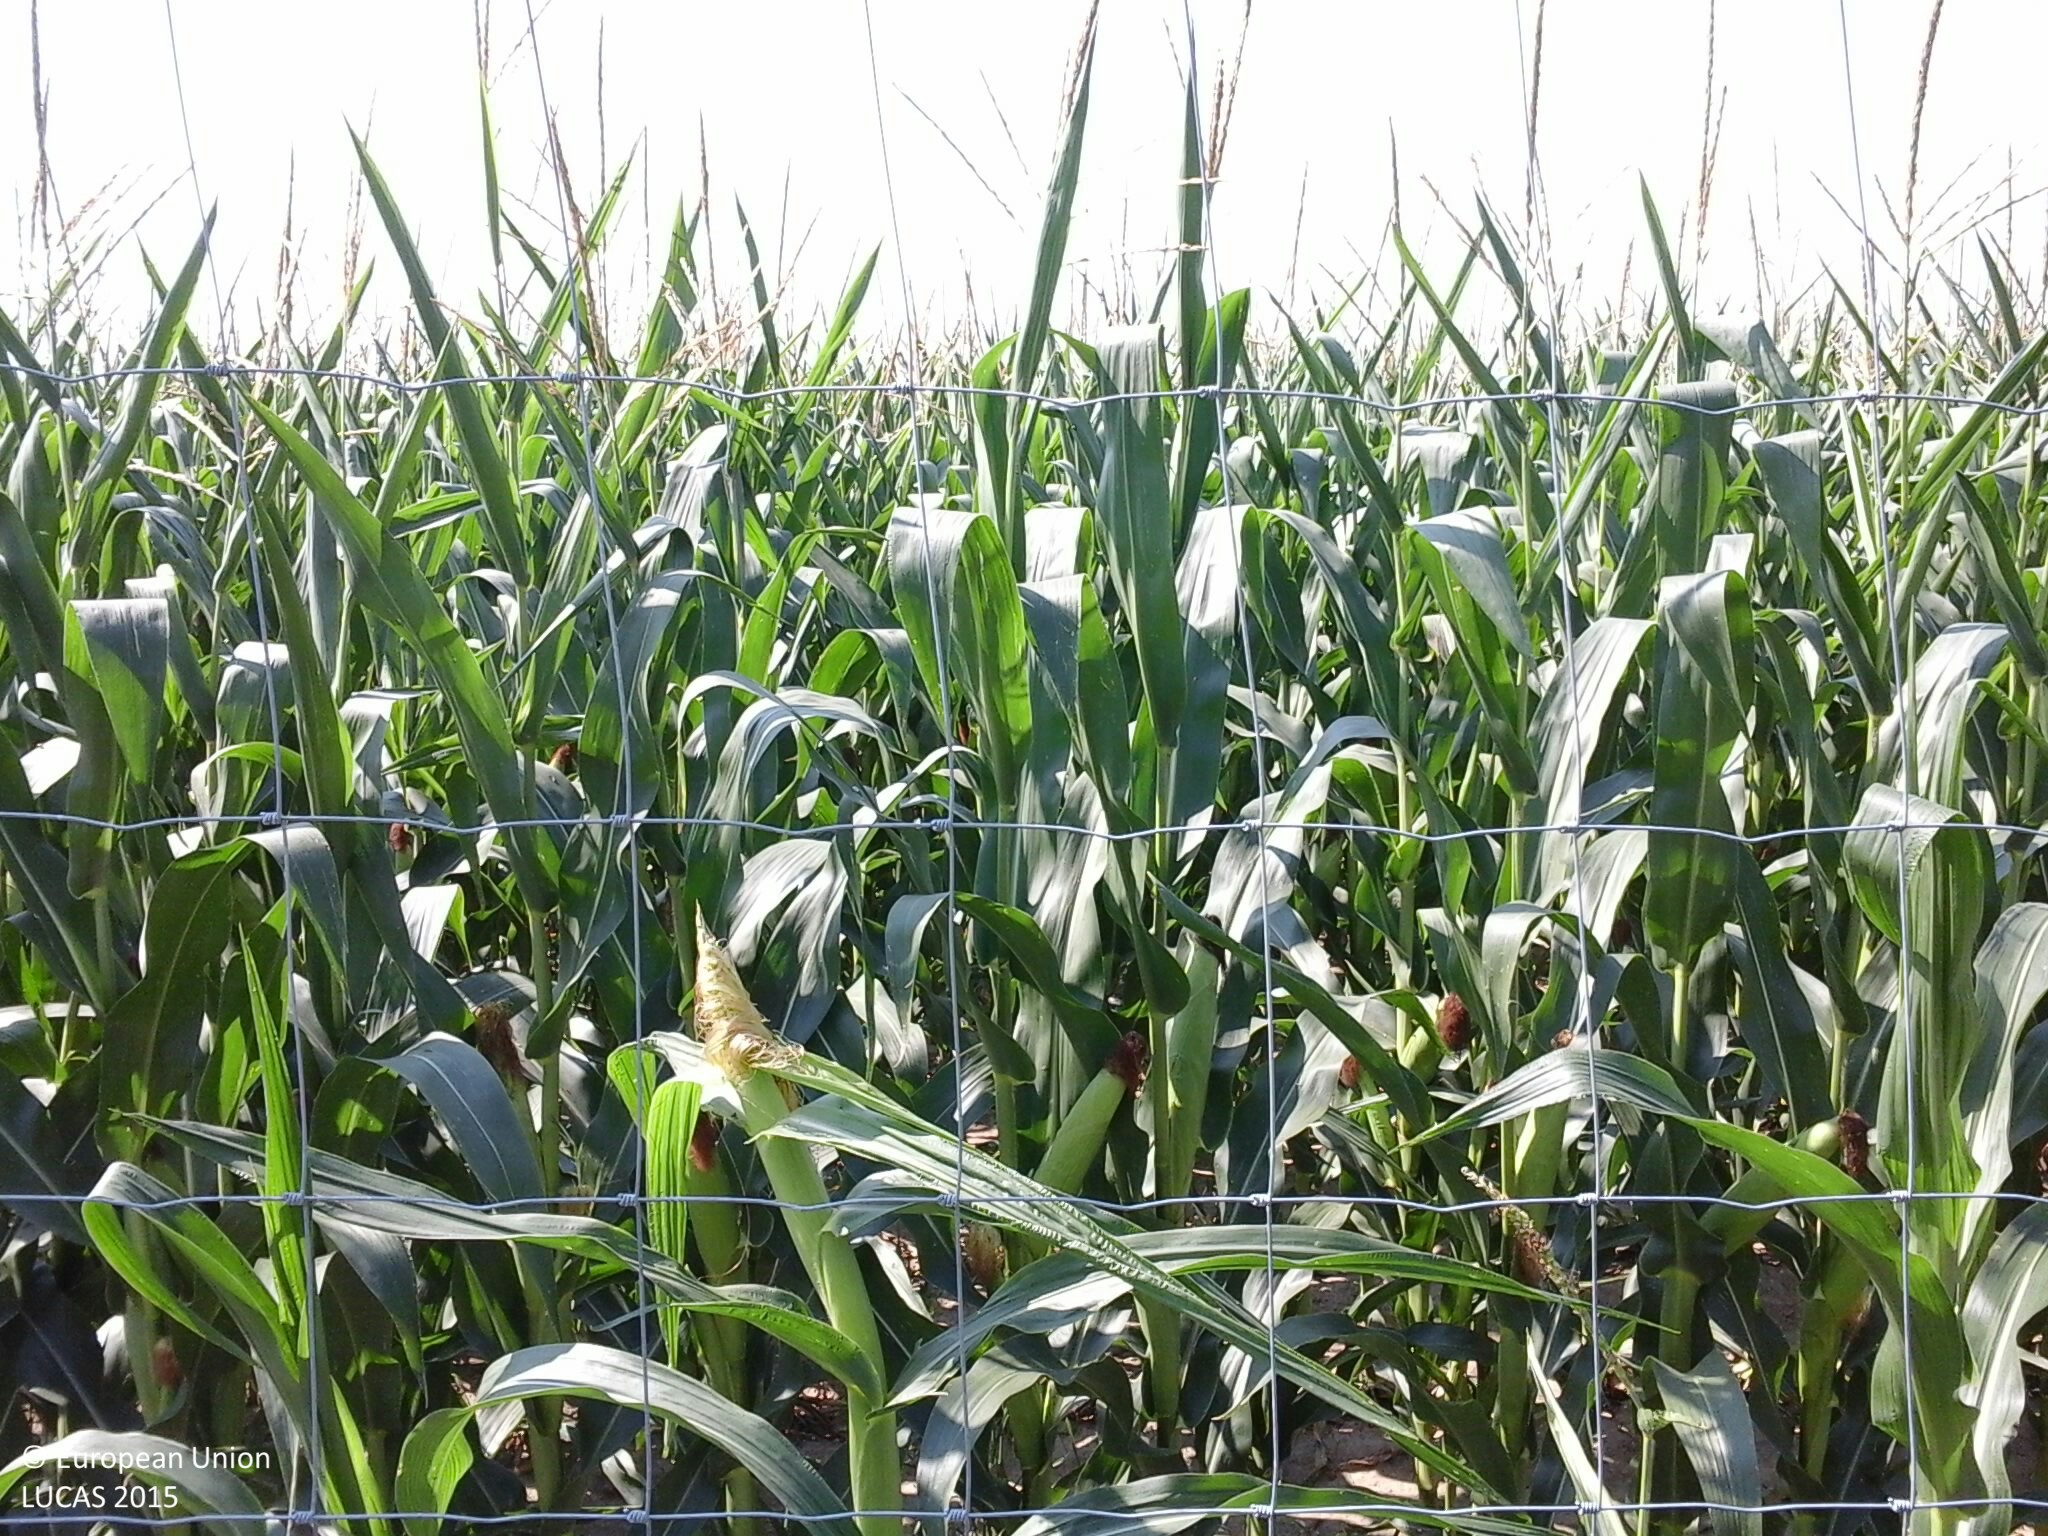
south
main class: Cropland
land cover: Maize
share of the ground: > 75 %
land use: Agriculture (excluding fallow land and kitchen gardens)
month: July
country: HU
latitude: 46.6743
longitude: 16.5509
